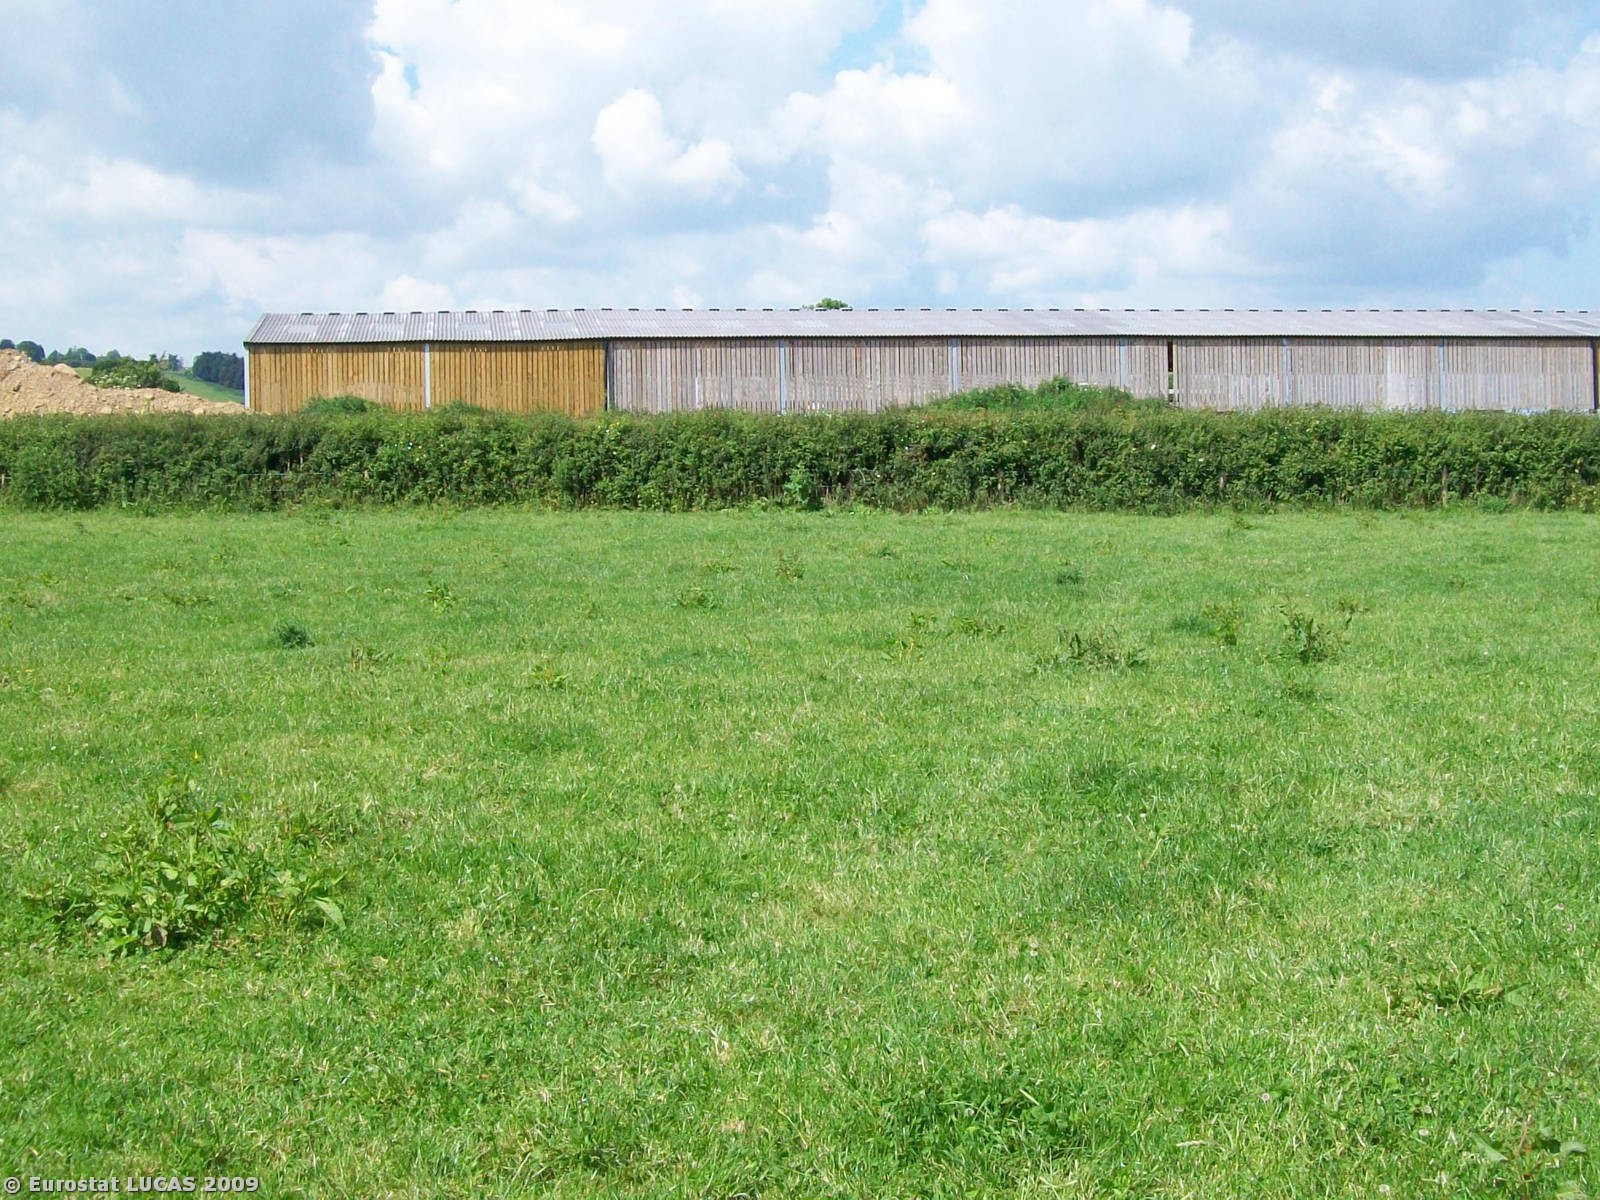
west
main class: Grassland
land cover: Grassland without tree/shrub cover
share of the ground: > 75 %
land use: Agriculture (excluding fallow land and kitchen gardens)
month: June
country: GB
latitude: 50.9698
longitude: -2.6430
